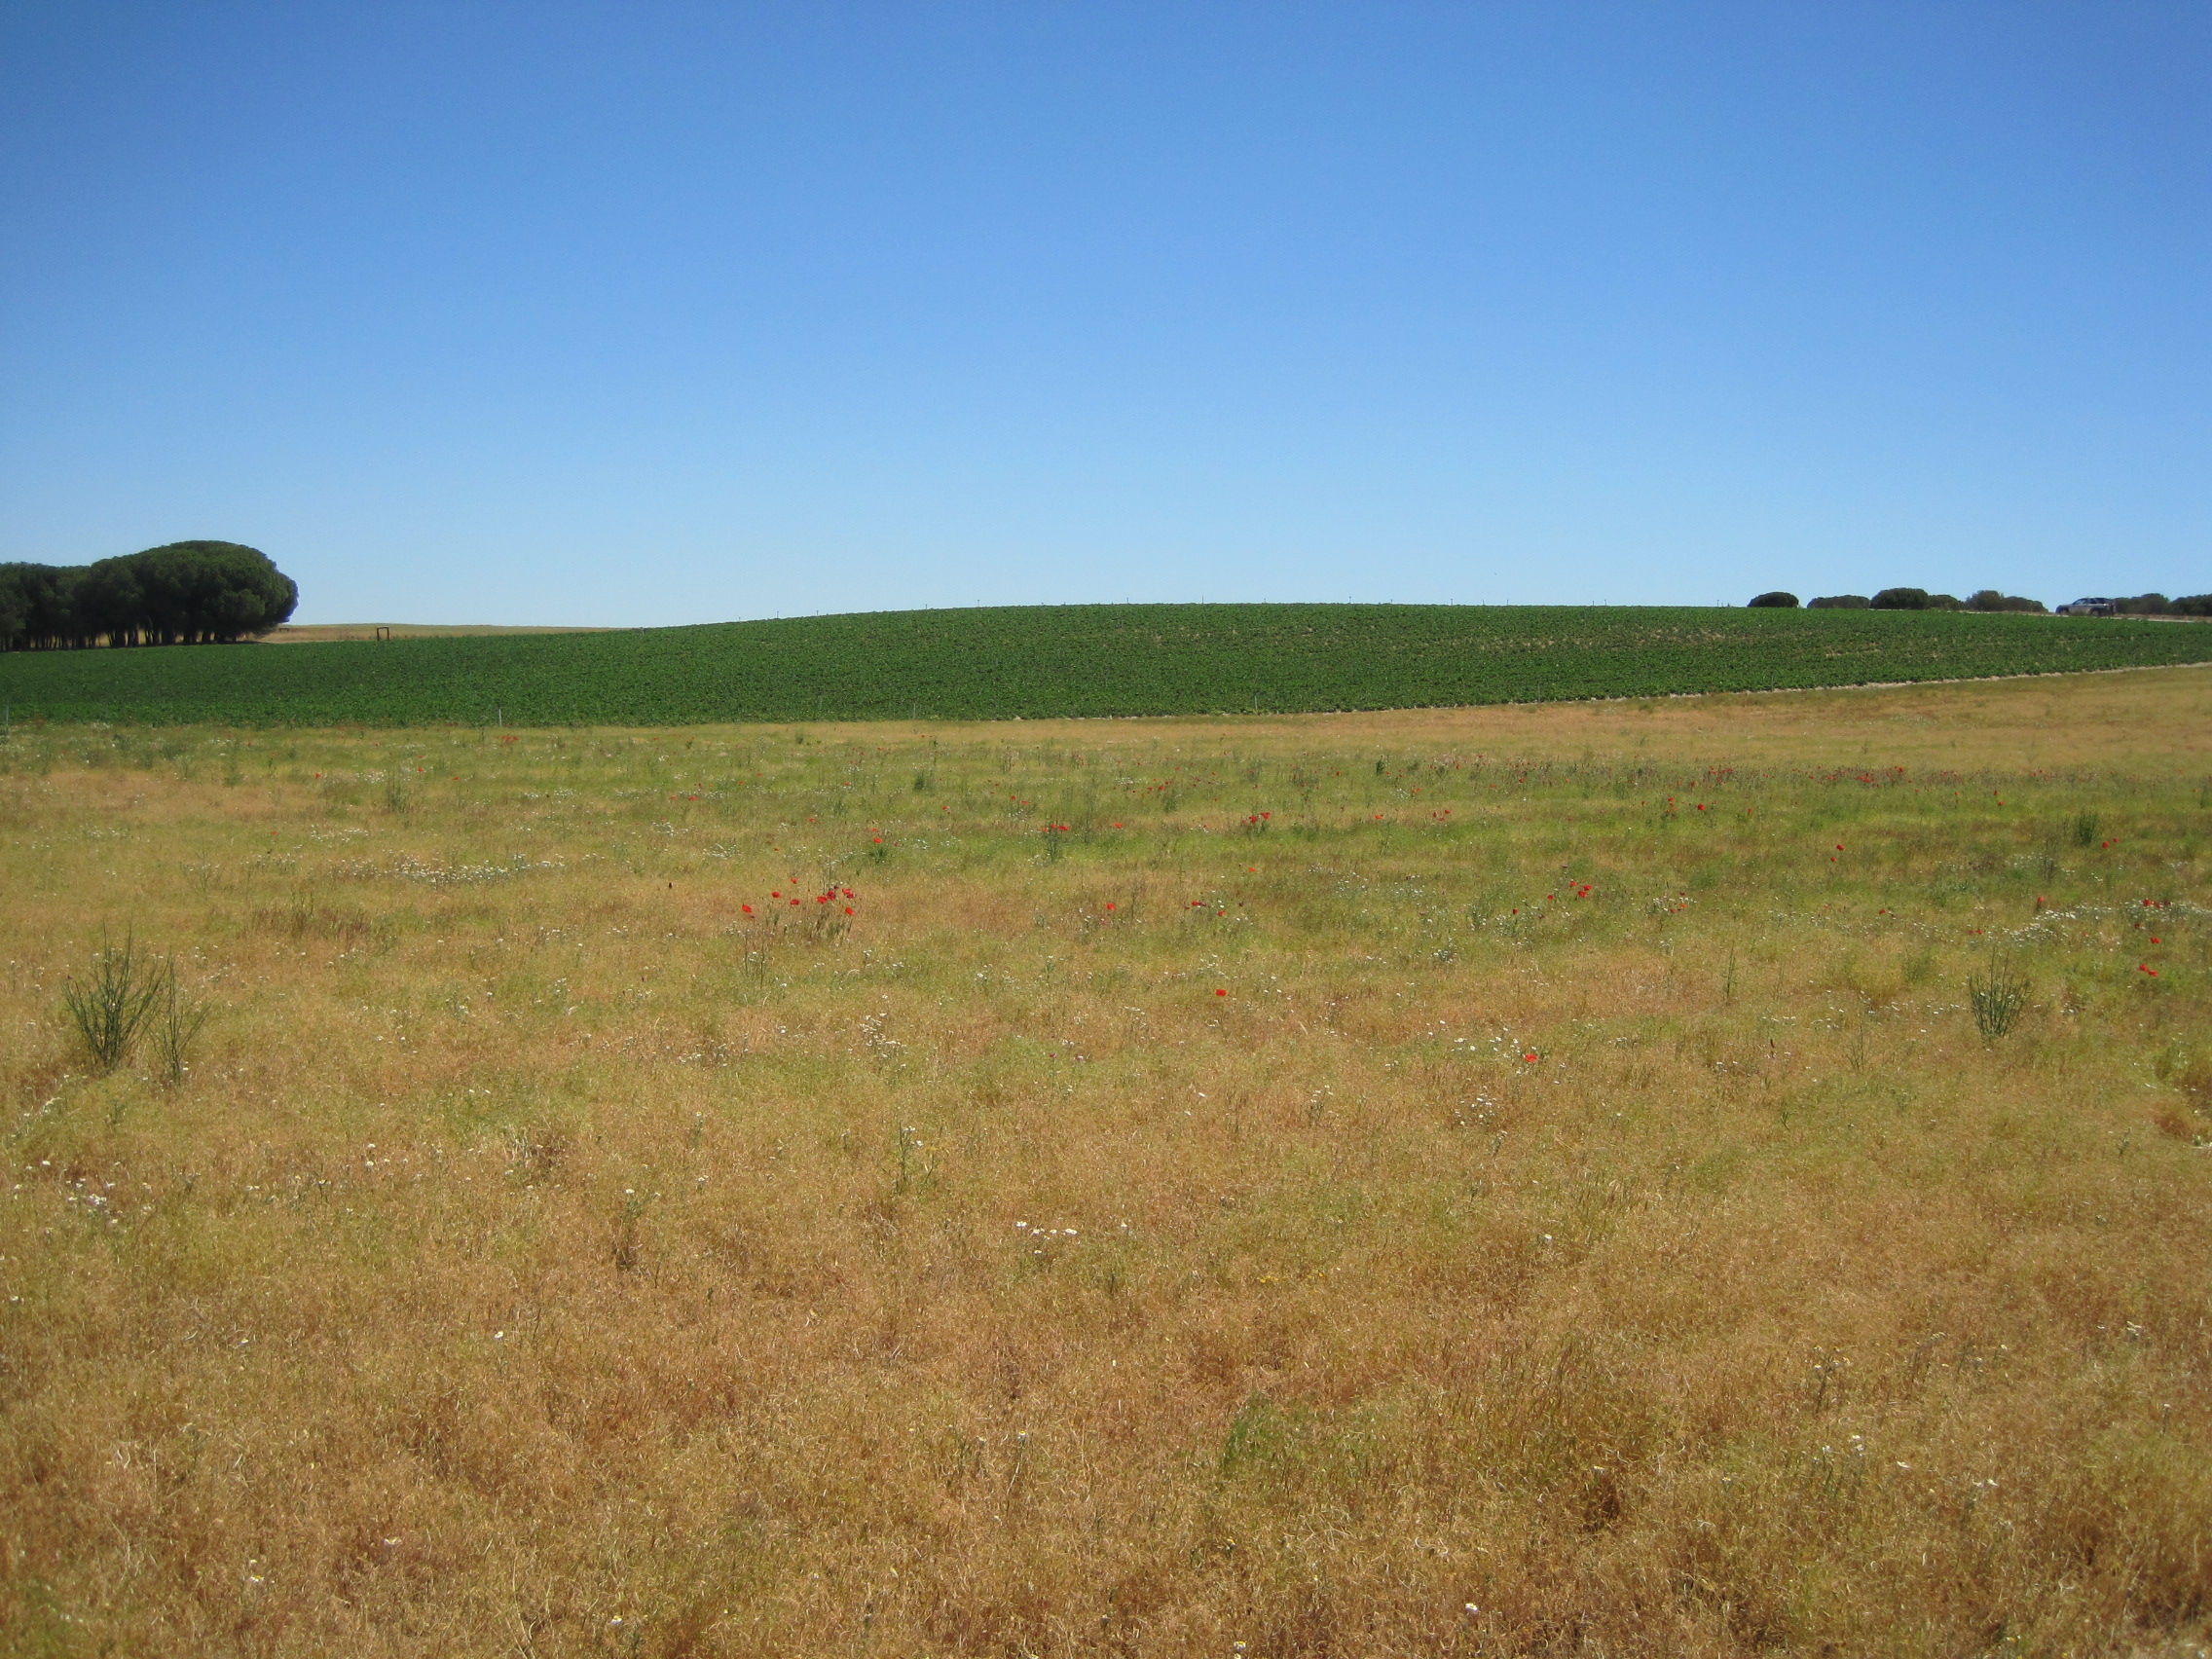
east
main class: Cropland
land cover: Dry pulses
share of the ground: > 75 %
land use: Agriculture (excluding fallow land and kitchen gardens)
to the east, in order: Dry pulses; Grass margins; Potatoes; Grass margins; Tracks
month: May
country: ES
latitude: 41.2894
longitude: -5.2507
